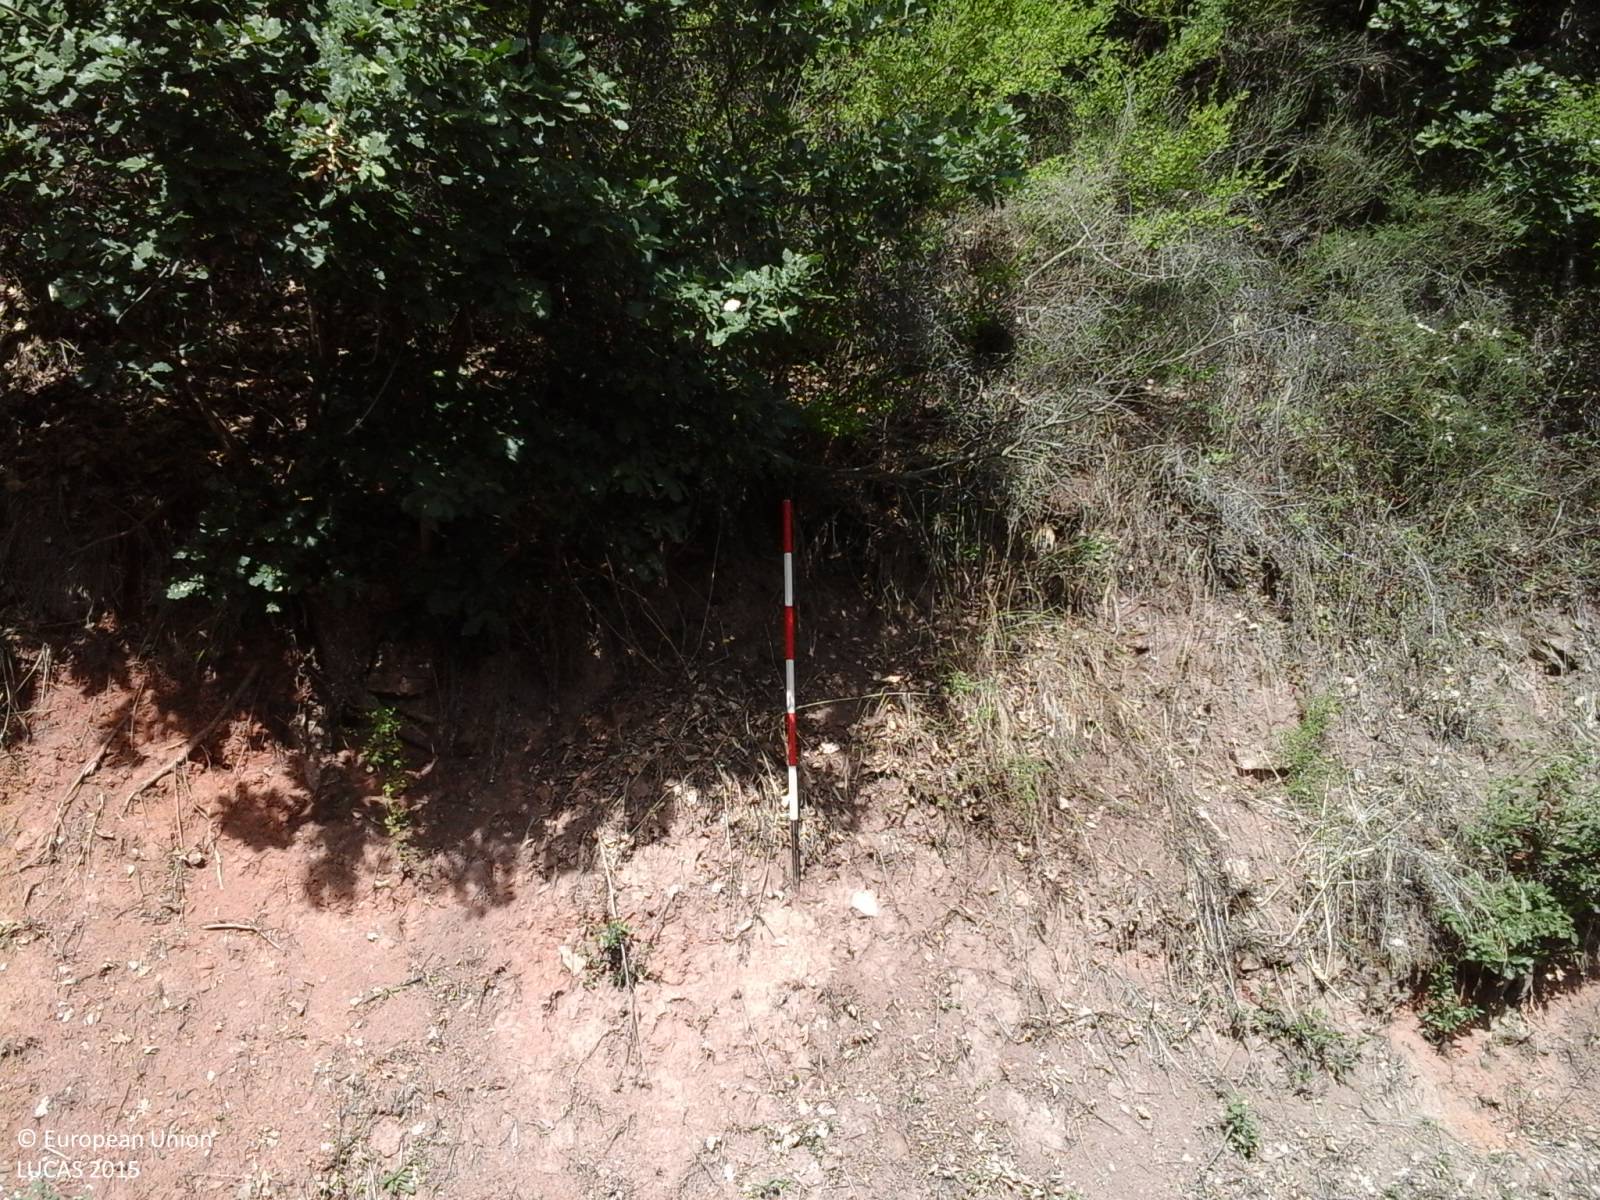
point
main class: Woodland
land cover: Broadleaved woodland
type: broadleaved evergreen forest
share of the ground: > 75 %
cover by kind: broadleaved forest trees 100 %
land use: Semi-natural and natural areas not in use
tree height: > 5 m
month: October
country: IT
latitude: 40.4001
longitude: 8.4643
